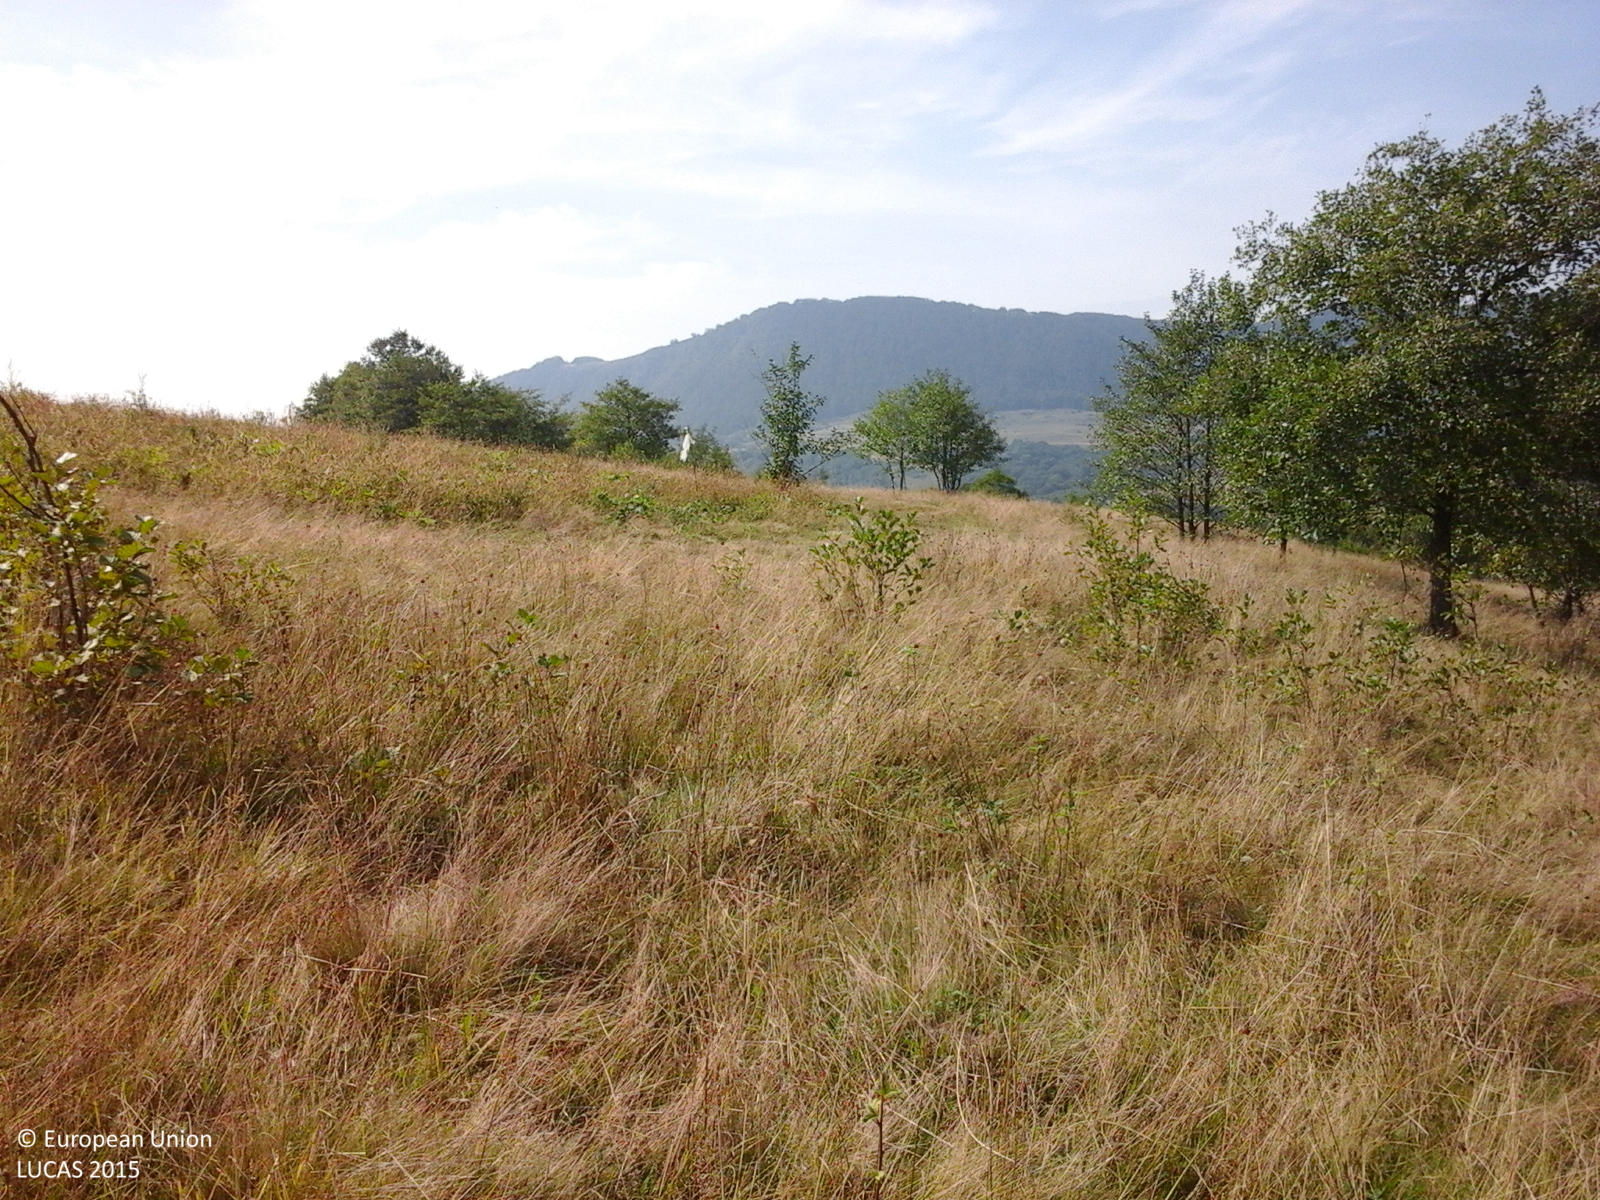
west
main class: Grassland
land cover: Grassland without tree/shrub cover
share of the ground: > 75 %
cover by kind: herbaceous plants 100 %
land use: Agriculture (excluding fallow land and kitchen gardens)
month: September
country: RO
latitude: 46.9279
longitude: 22.9449
